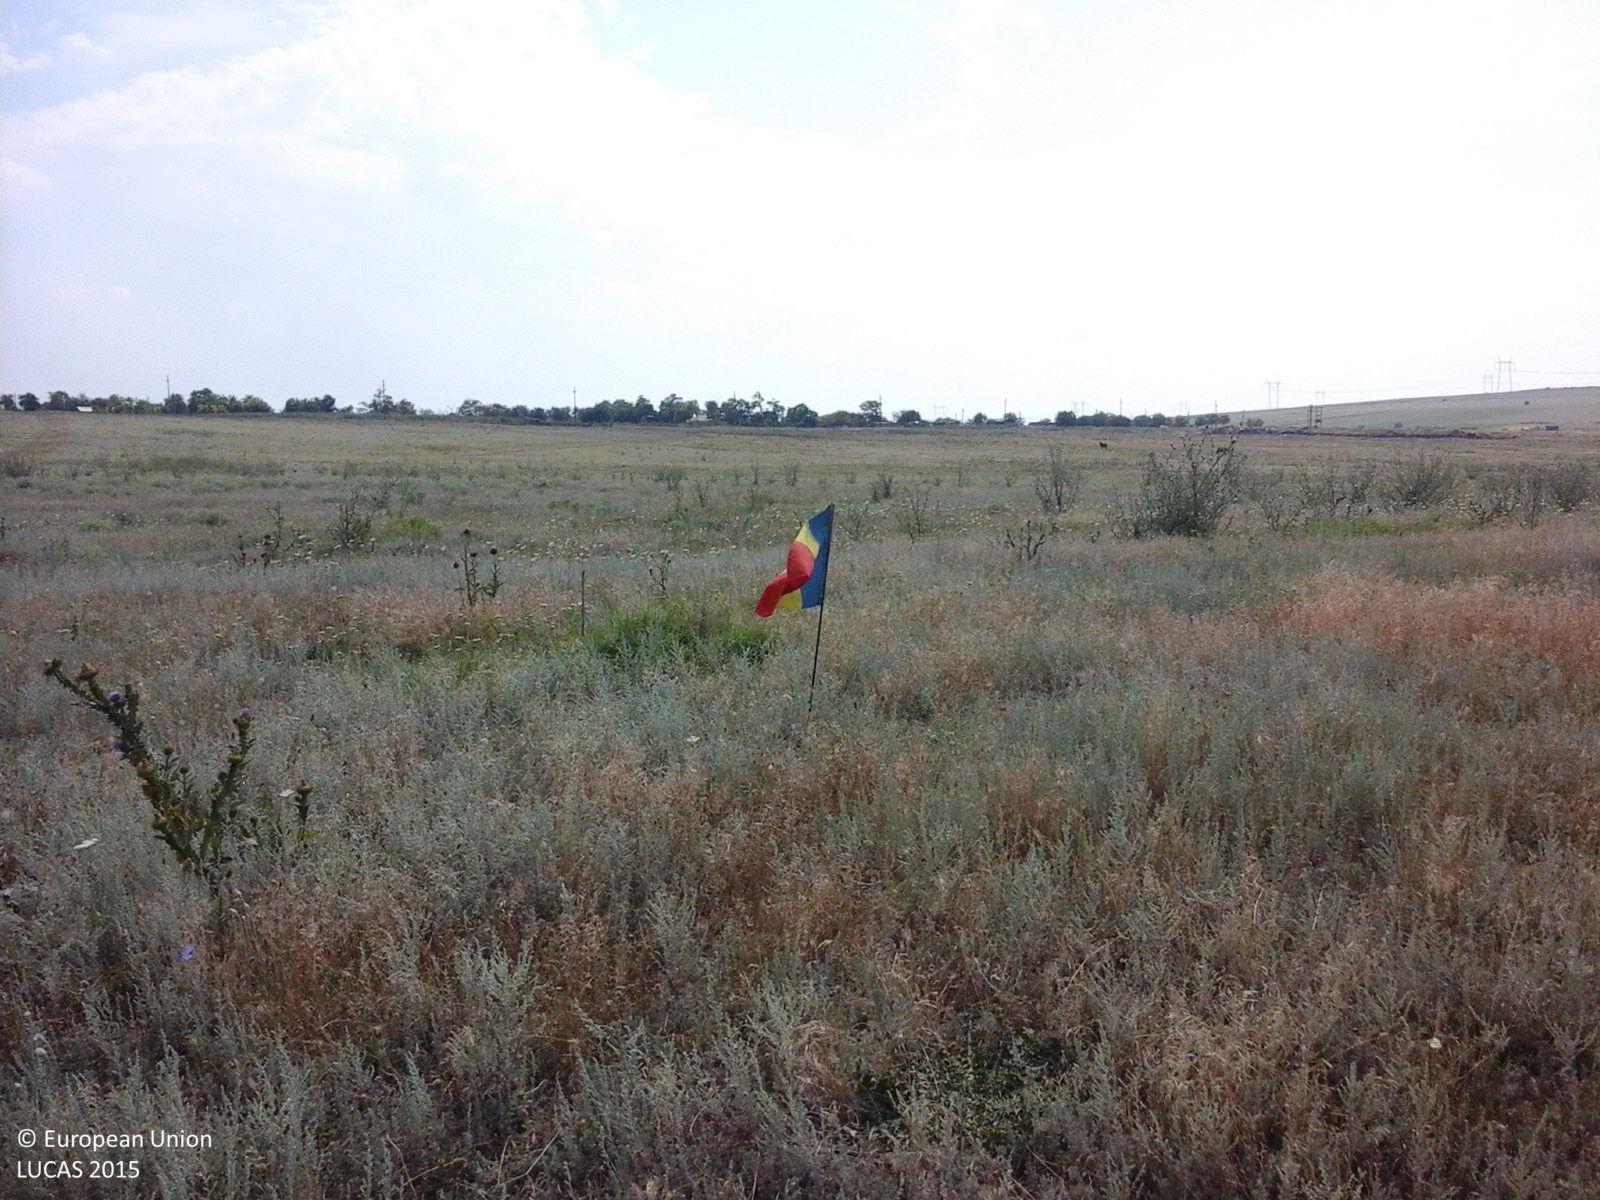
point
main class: Grassland
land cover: Spontaneously vegetated surfaces
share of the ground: > 75 %
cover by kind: herbaceous plants 100 %
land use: Agriculture (excluding fallow land and kitchen gardens)
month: July
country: RO
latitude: 44.8685
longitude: 28.2831
